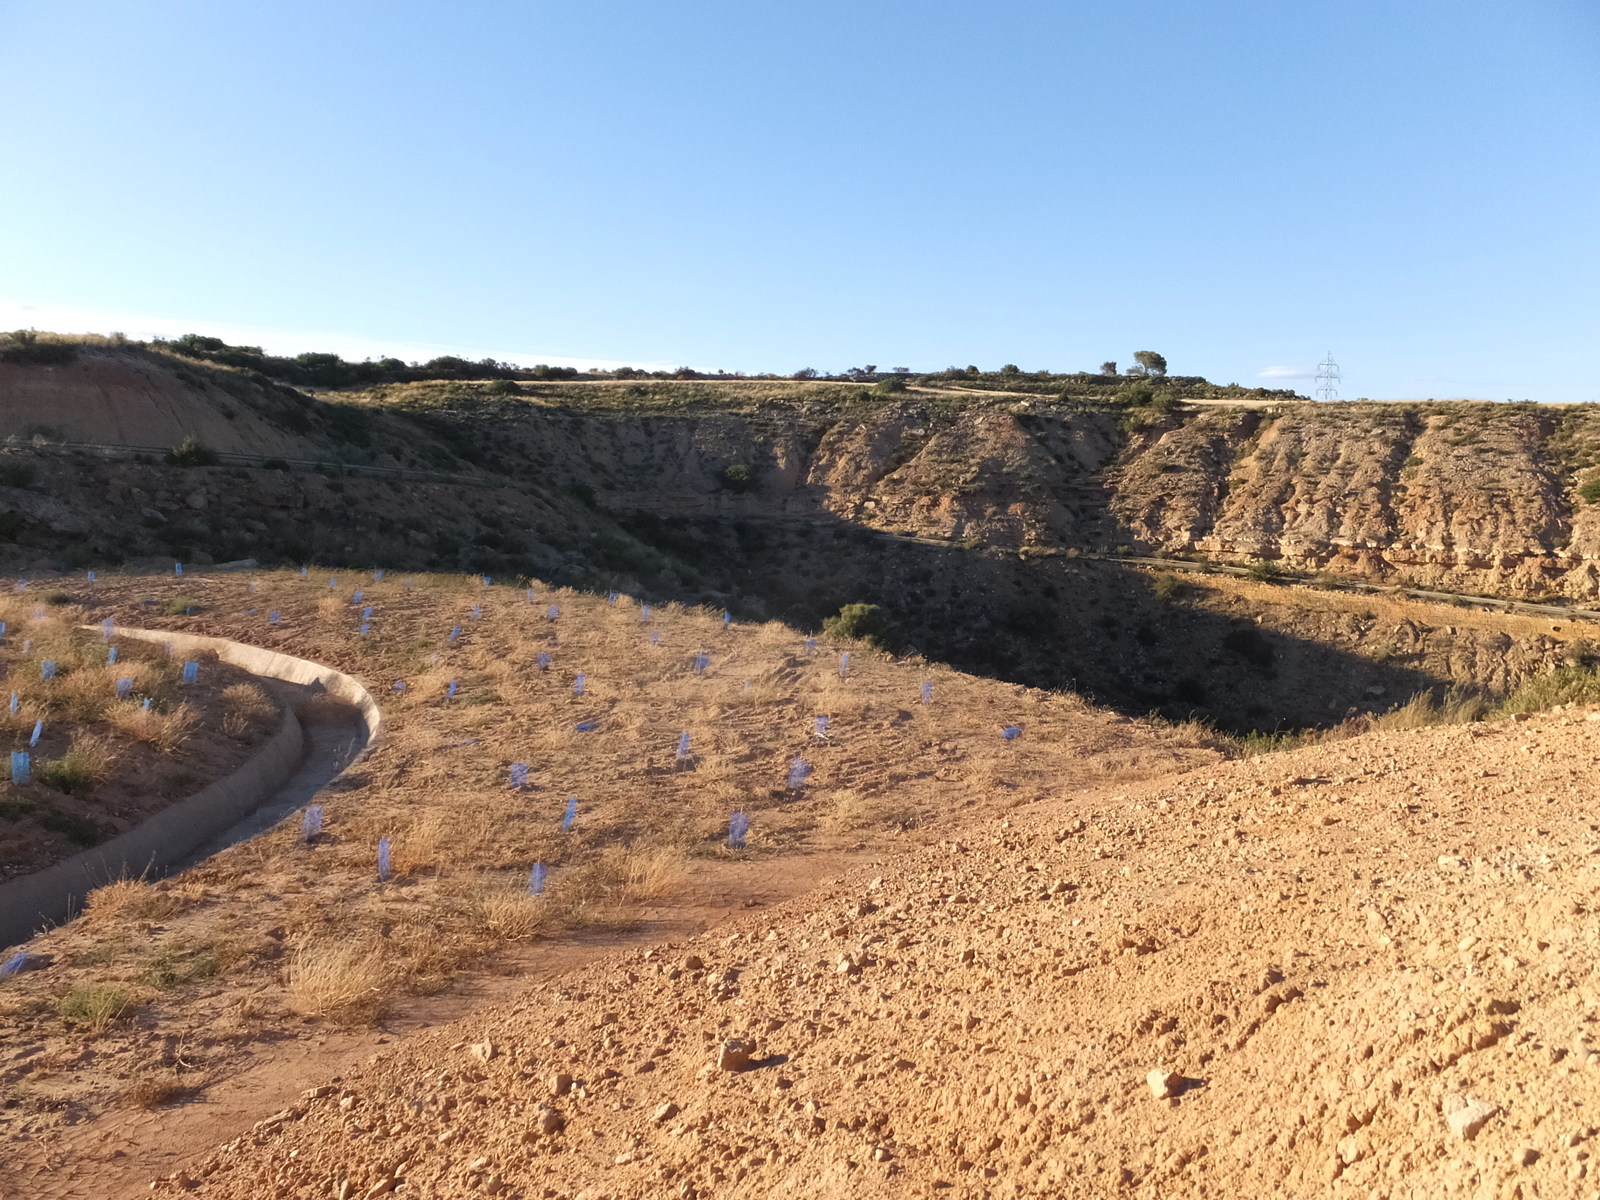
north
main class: Shrubland
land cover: Shrubland with sparse tree cover
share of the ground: > 75 %
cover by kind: unconsolidated bare surface 65 %, shrubs 20 %, herbaceous plants 10 %, coniferous forest trees 5 %
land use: Semi-natural and natural areas not in use
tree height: < 5 m
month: June
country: ES
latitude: 41.3038
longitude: -0.3460
